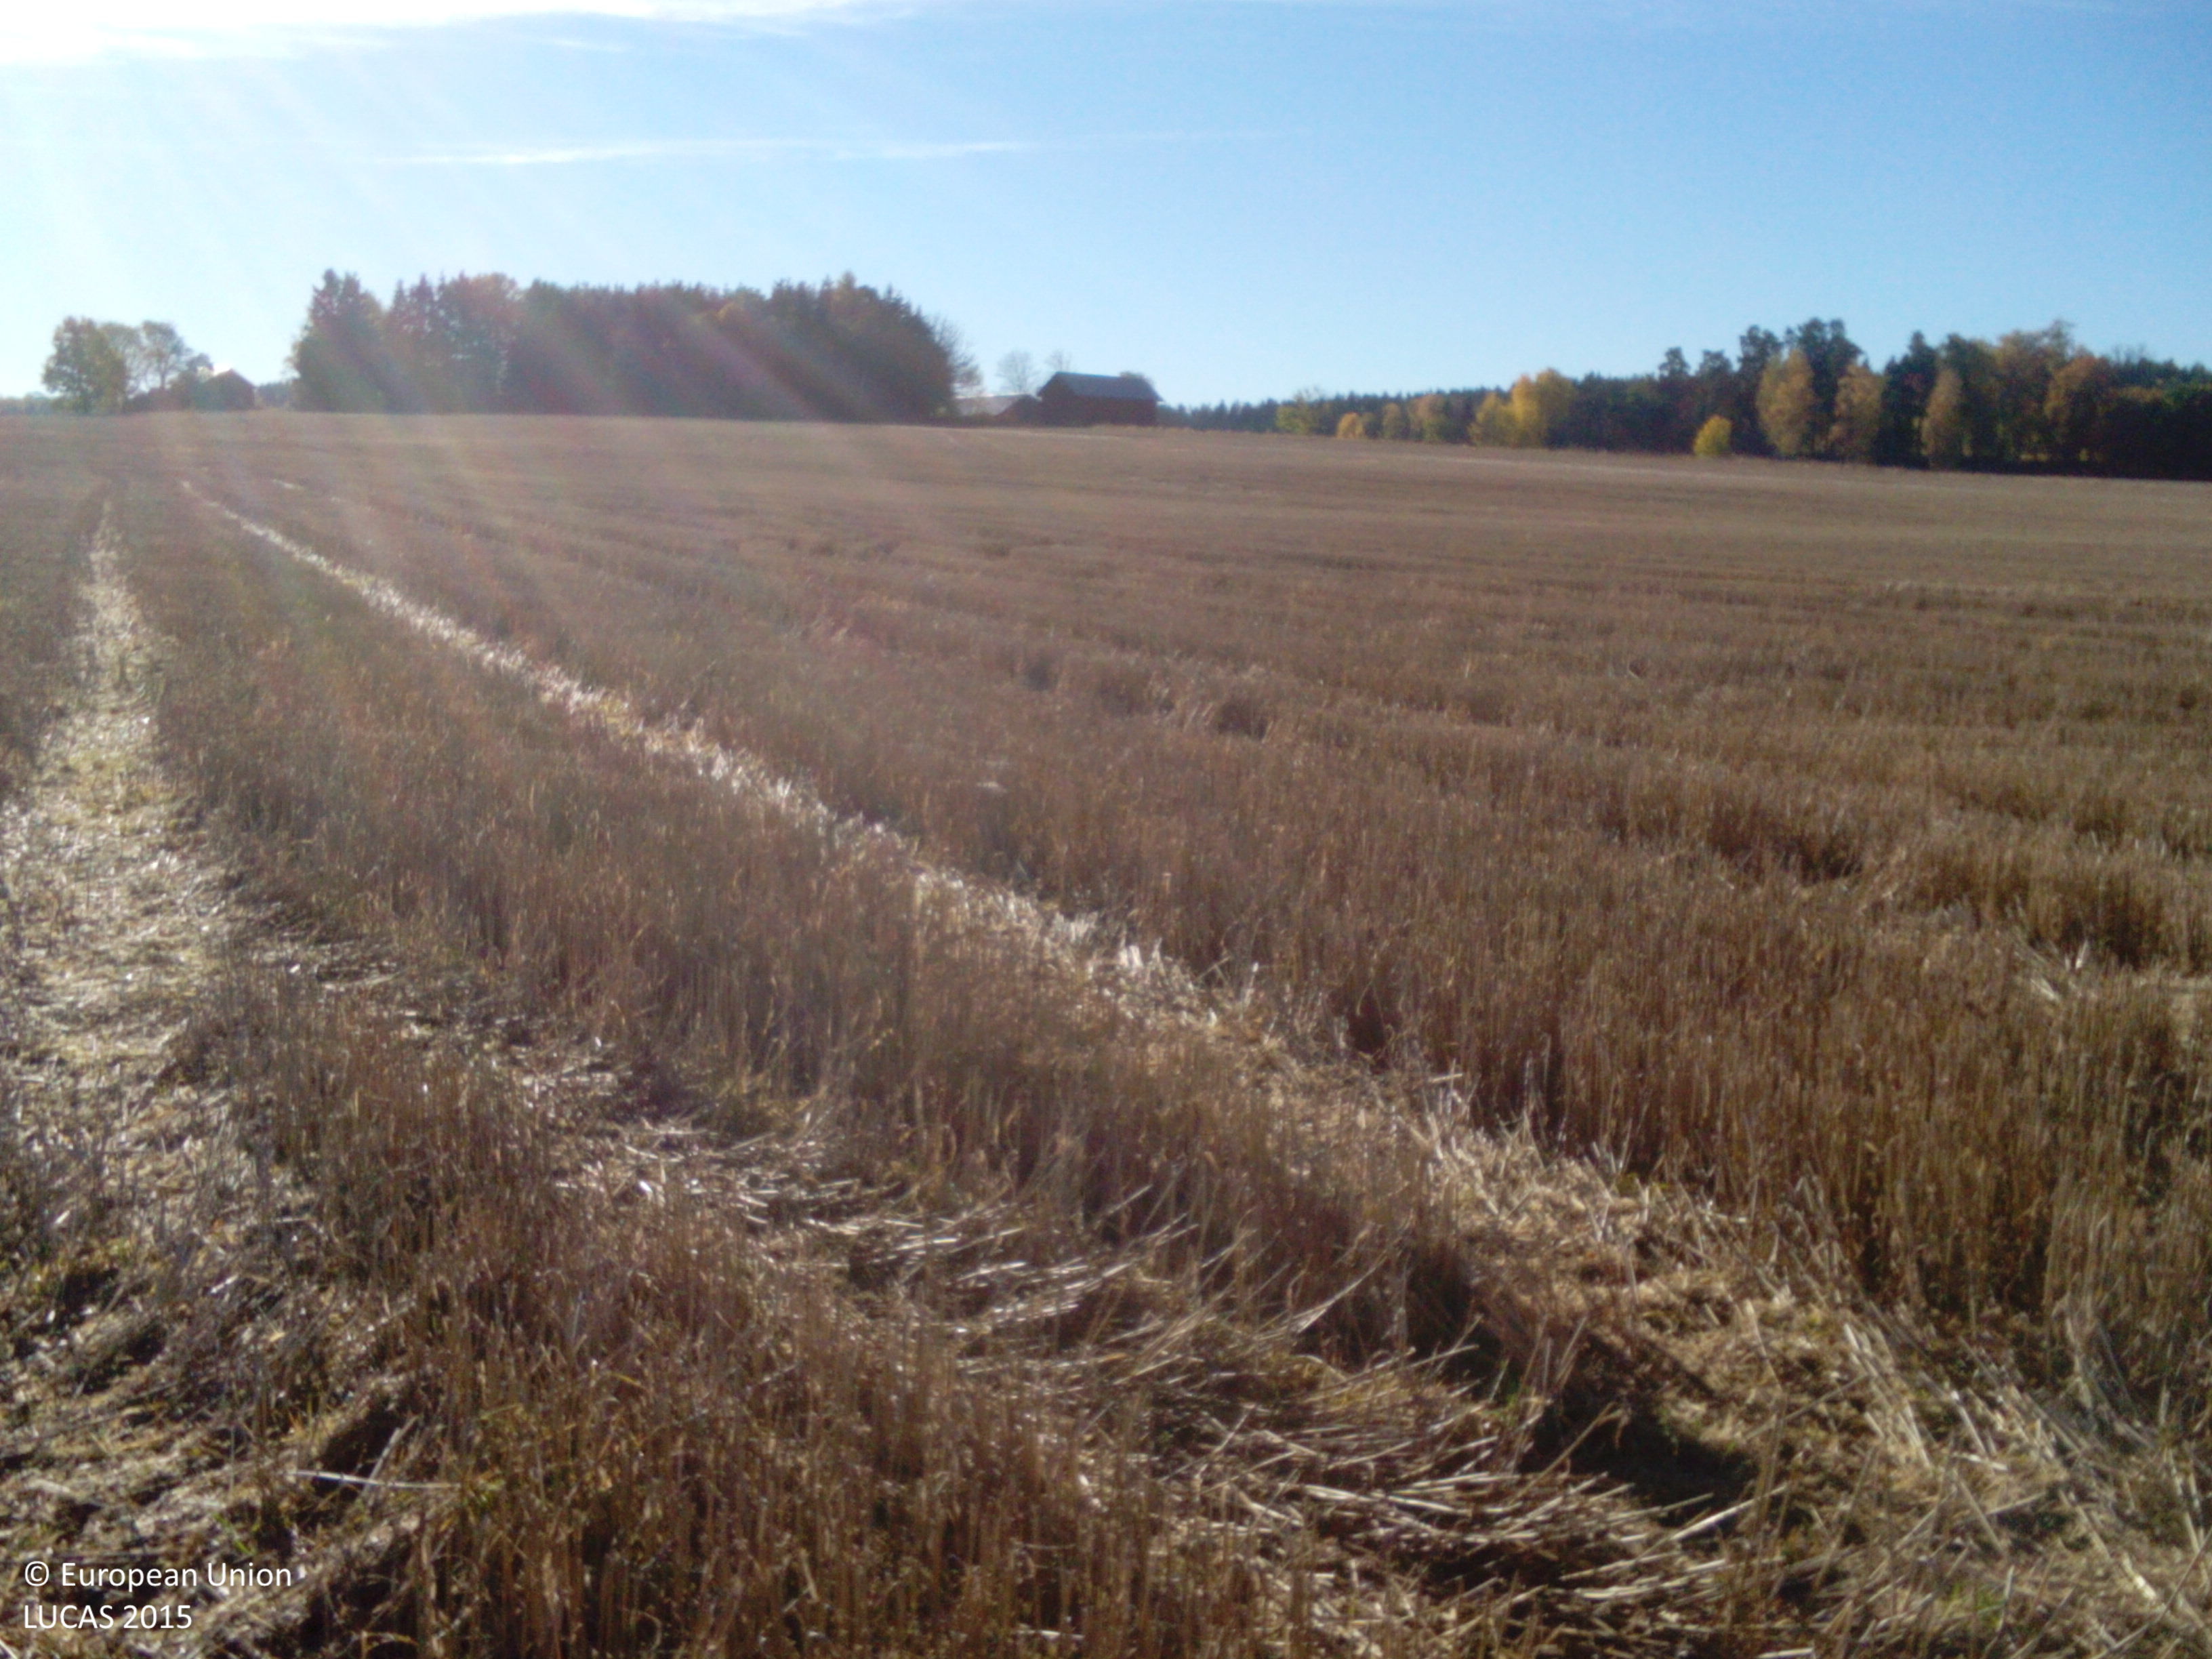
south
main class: Cropland
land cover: Common wheat
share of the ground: > 75 %
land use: Agriculture (excluding fallow land and kitchen gardens)
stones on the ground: < 10 %
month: October
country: SE
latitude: 59.0620
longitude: 16.3590
